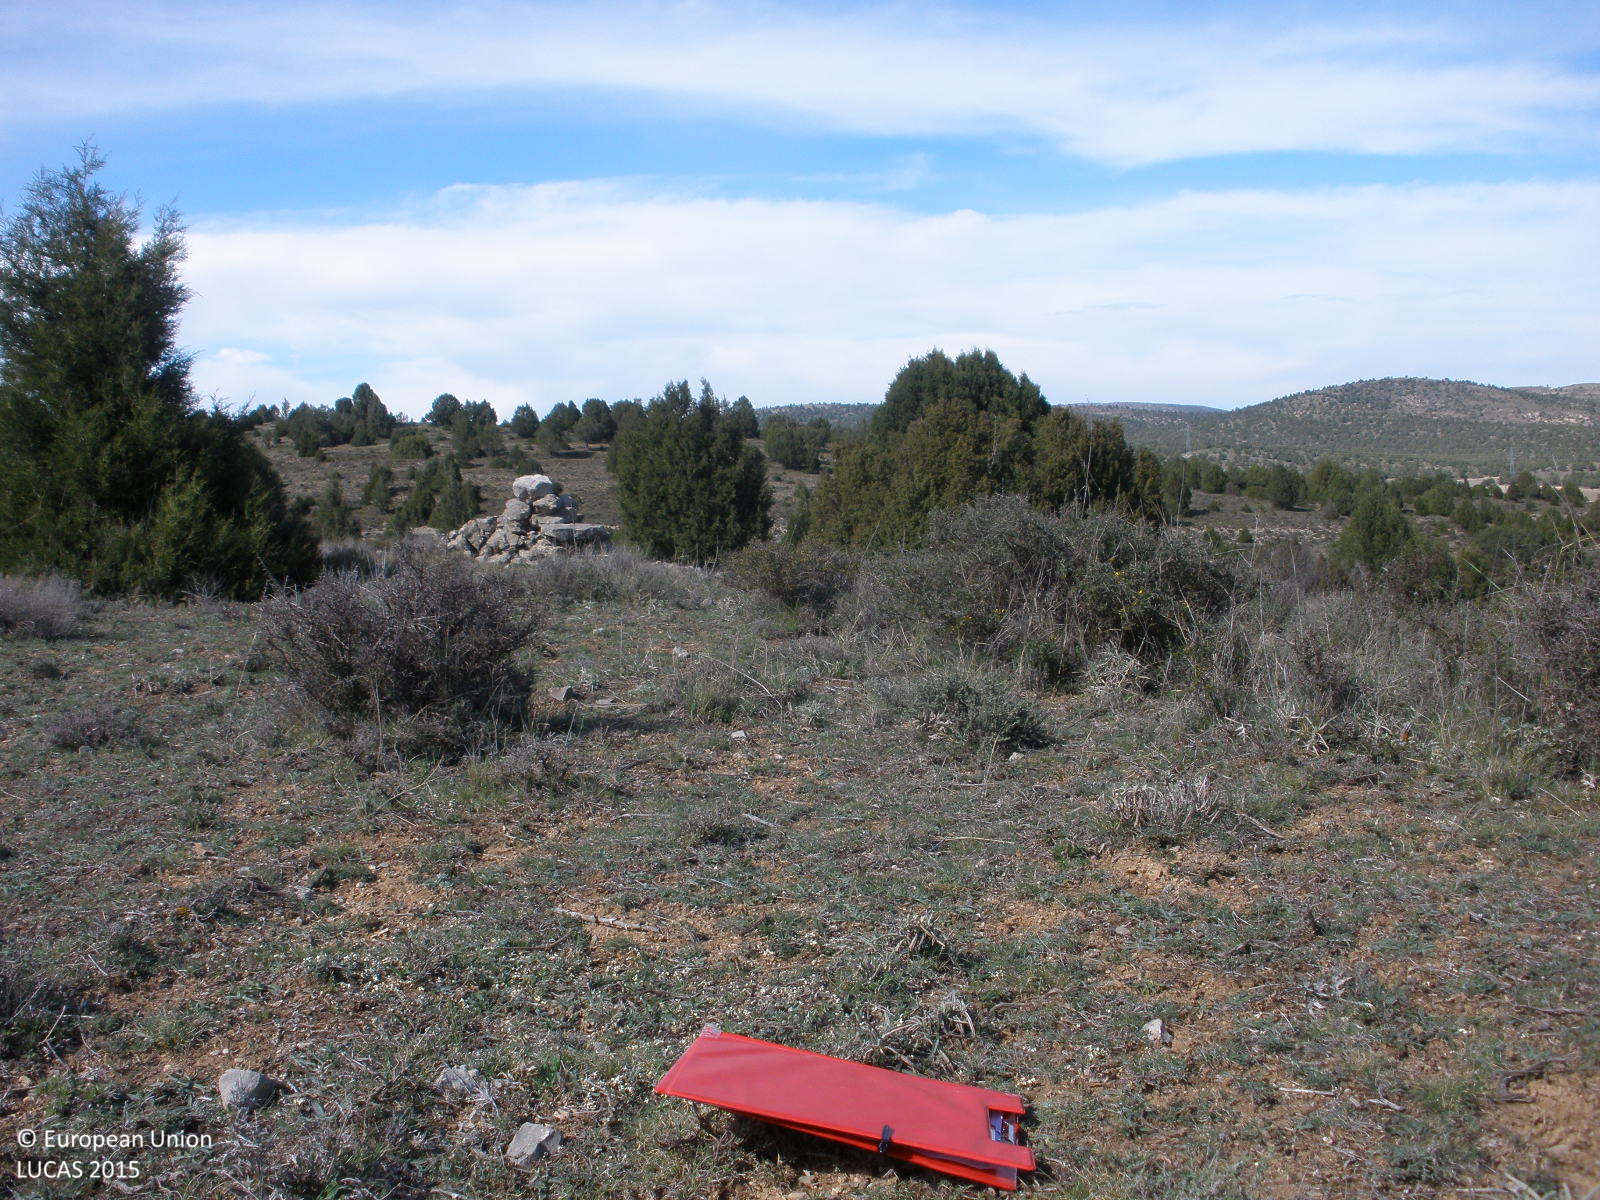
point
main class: Shrubland
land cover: Shrubland with sparse tree cover
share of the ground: 25 - 50 %
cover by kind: shrubs 40 %, consolidated bare surface 30 %, herbaceous plants 25 %, coniferous forest trees 5 %
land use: Agriculture (excluding fallow land and kitchen gardens)
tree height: < 5 m
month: April
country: ES
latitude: 40.2514
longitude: -0.9776
